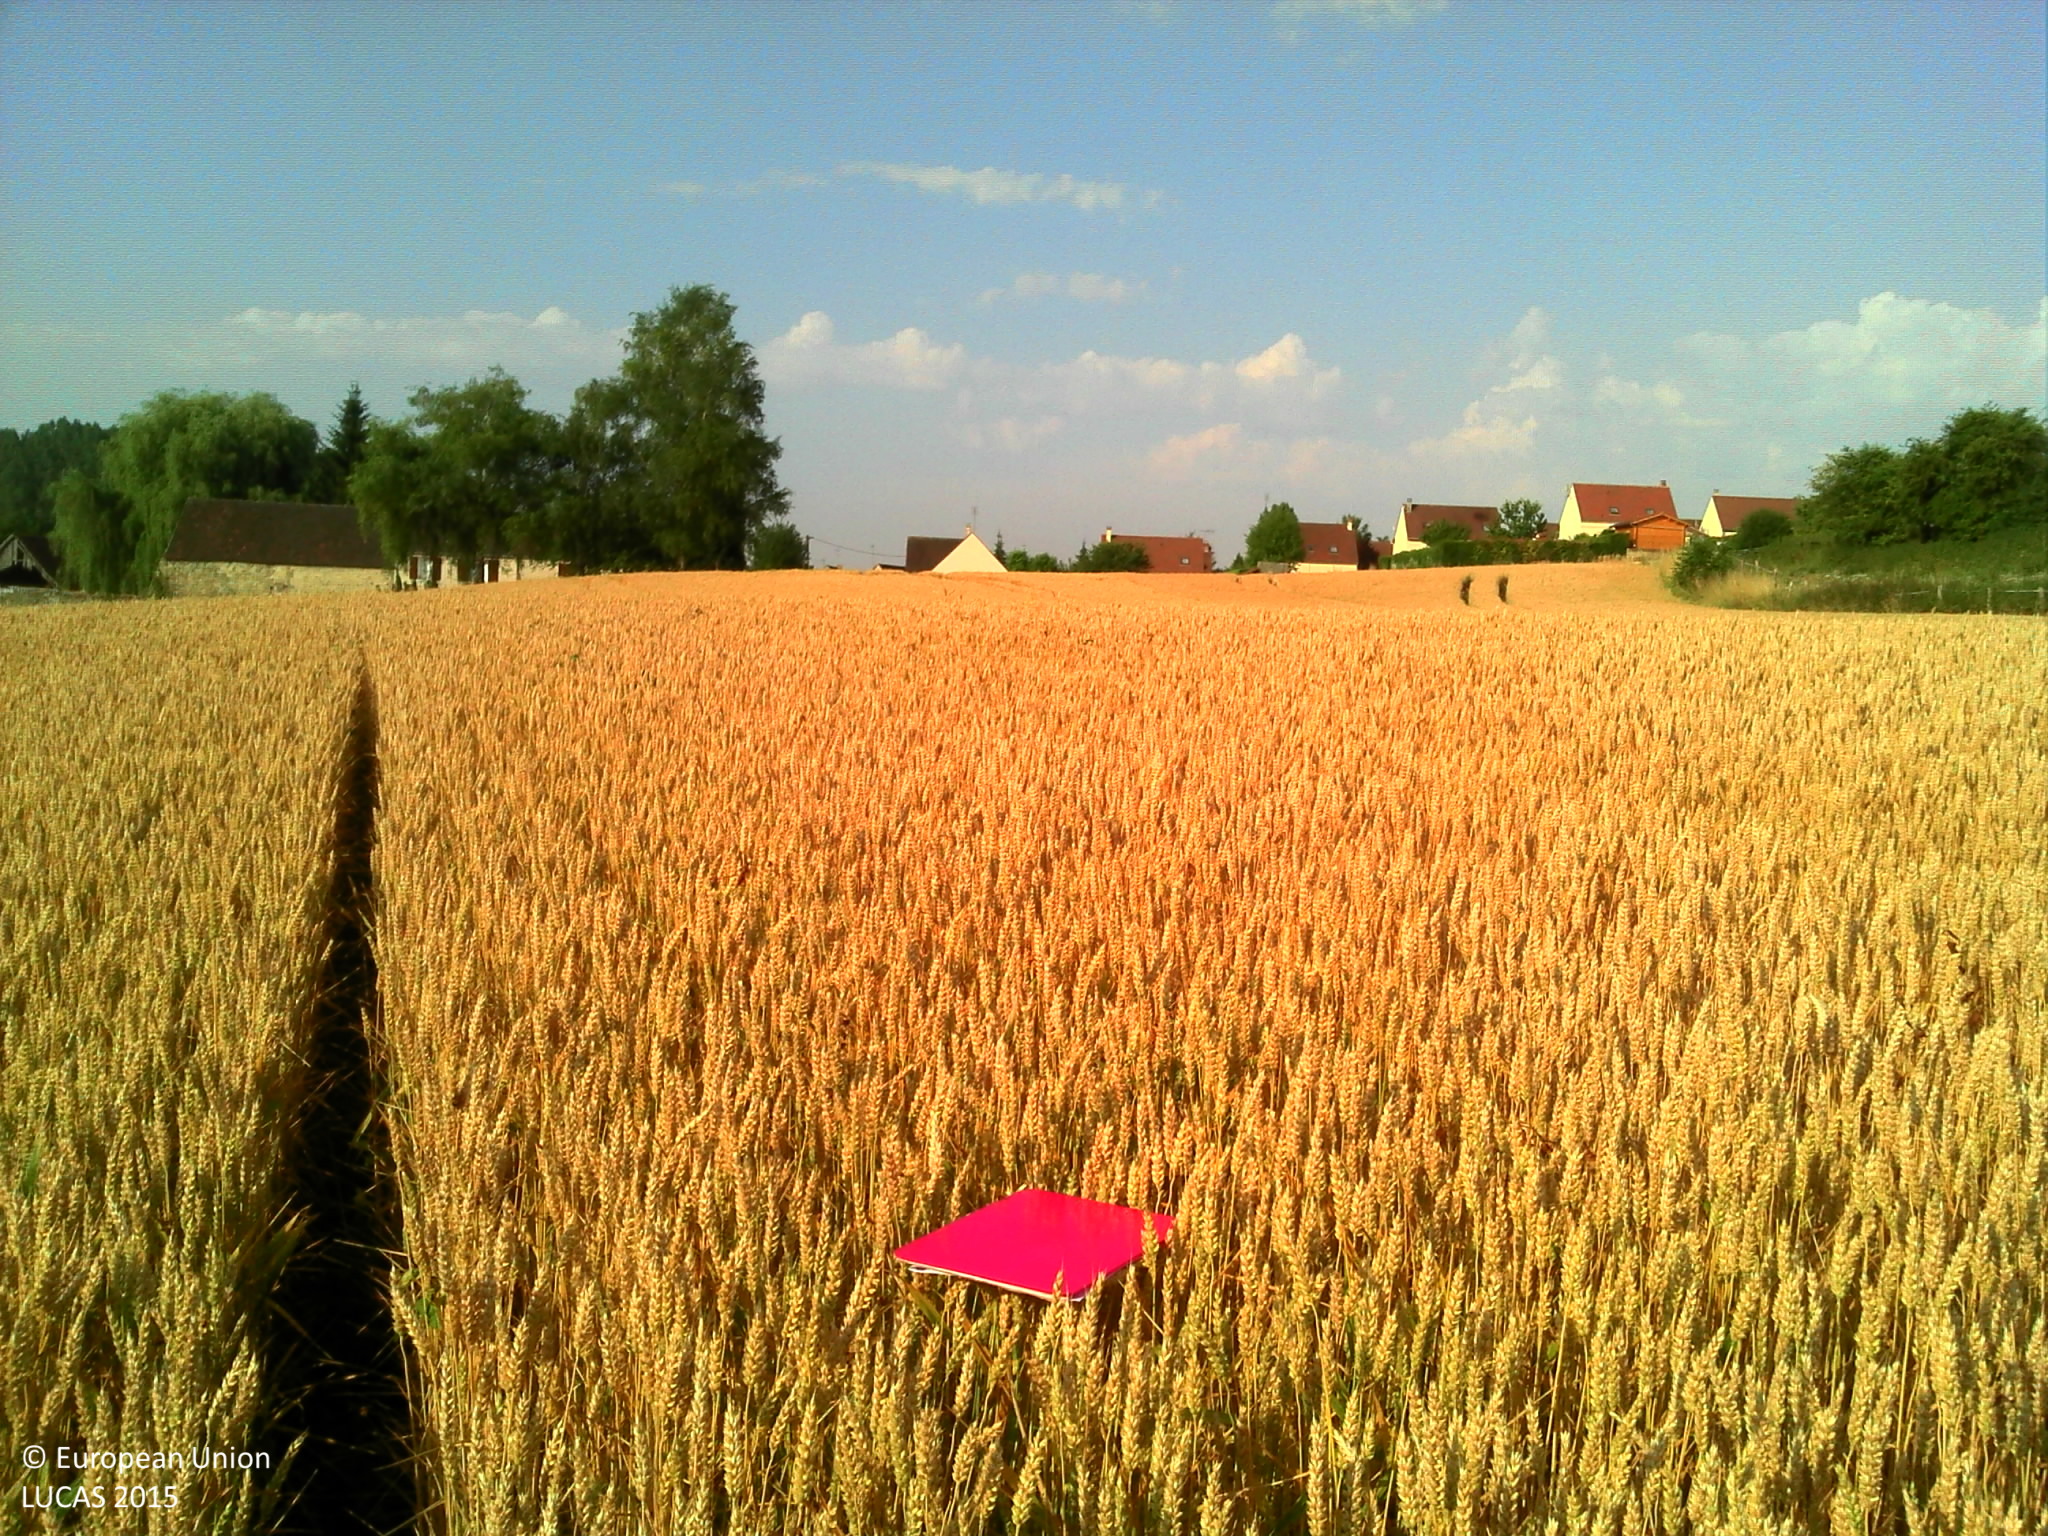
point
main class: Cropland
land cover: Common wheat
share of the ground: > 75 %
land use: Agriculture (excluding fallow land and kitchen gardens)
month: July
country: FR
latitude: 49.3080
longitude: 2.5475
